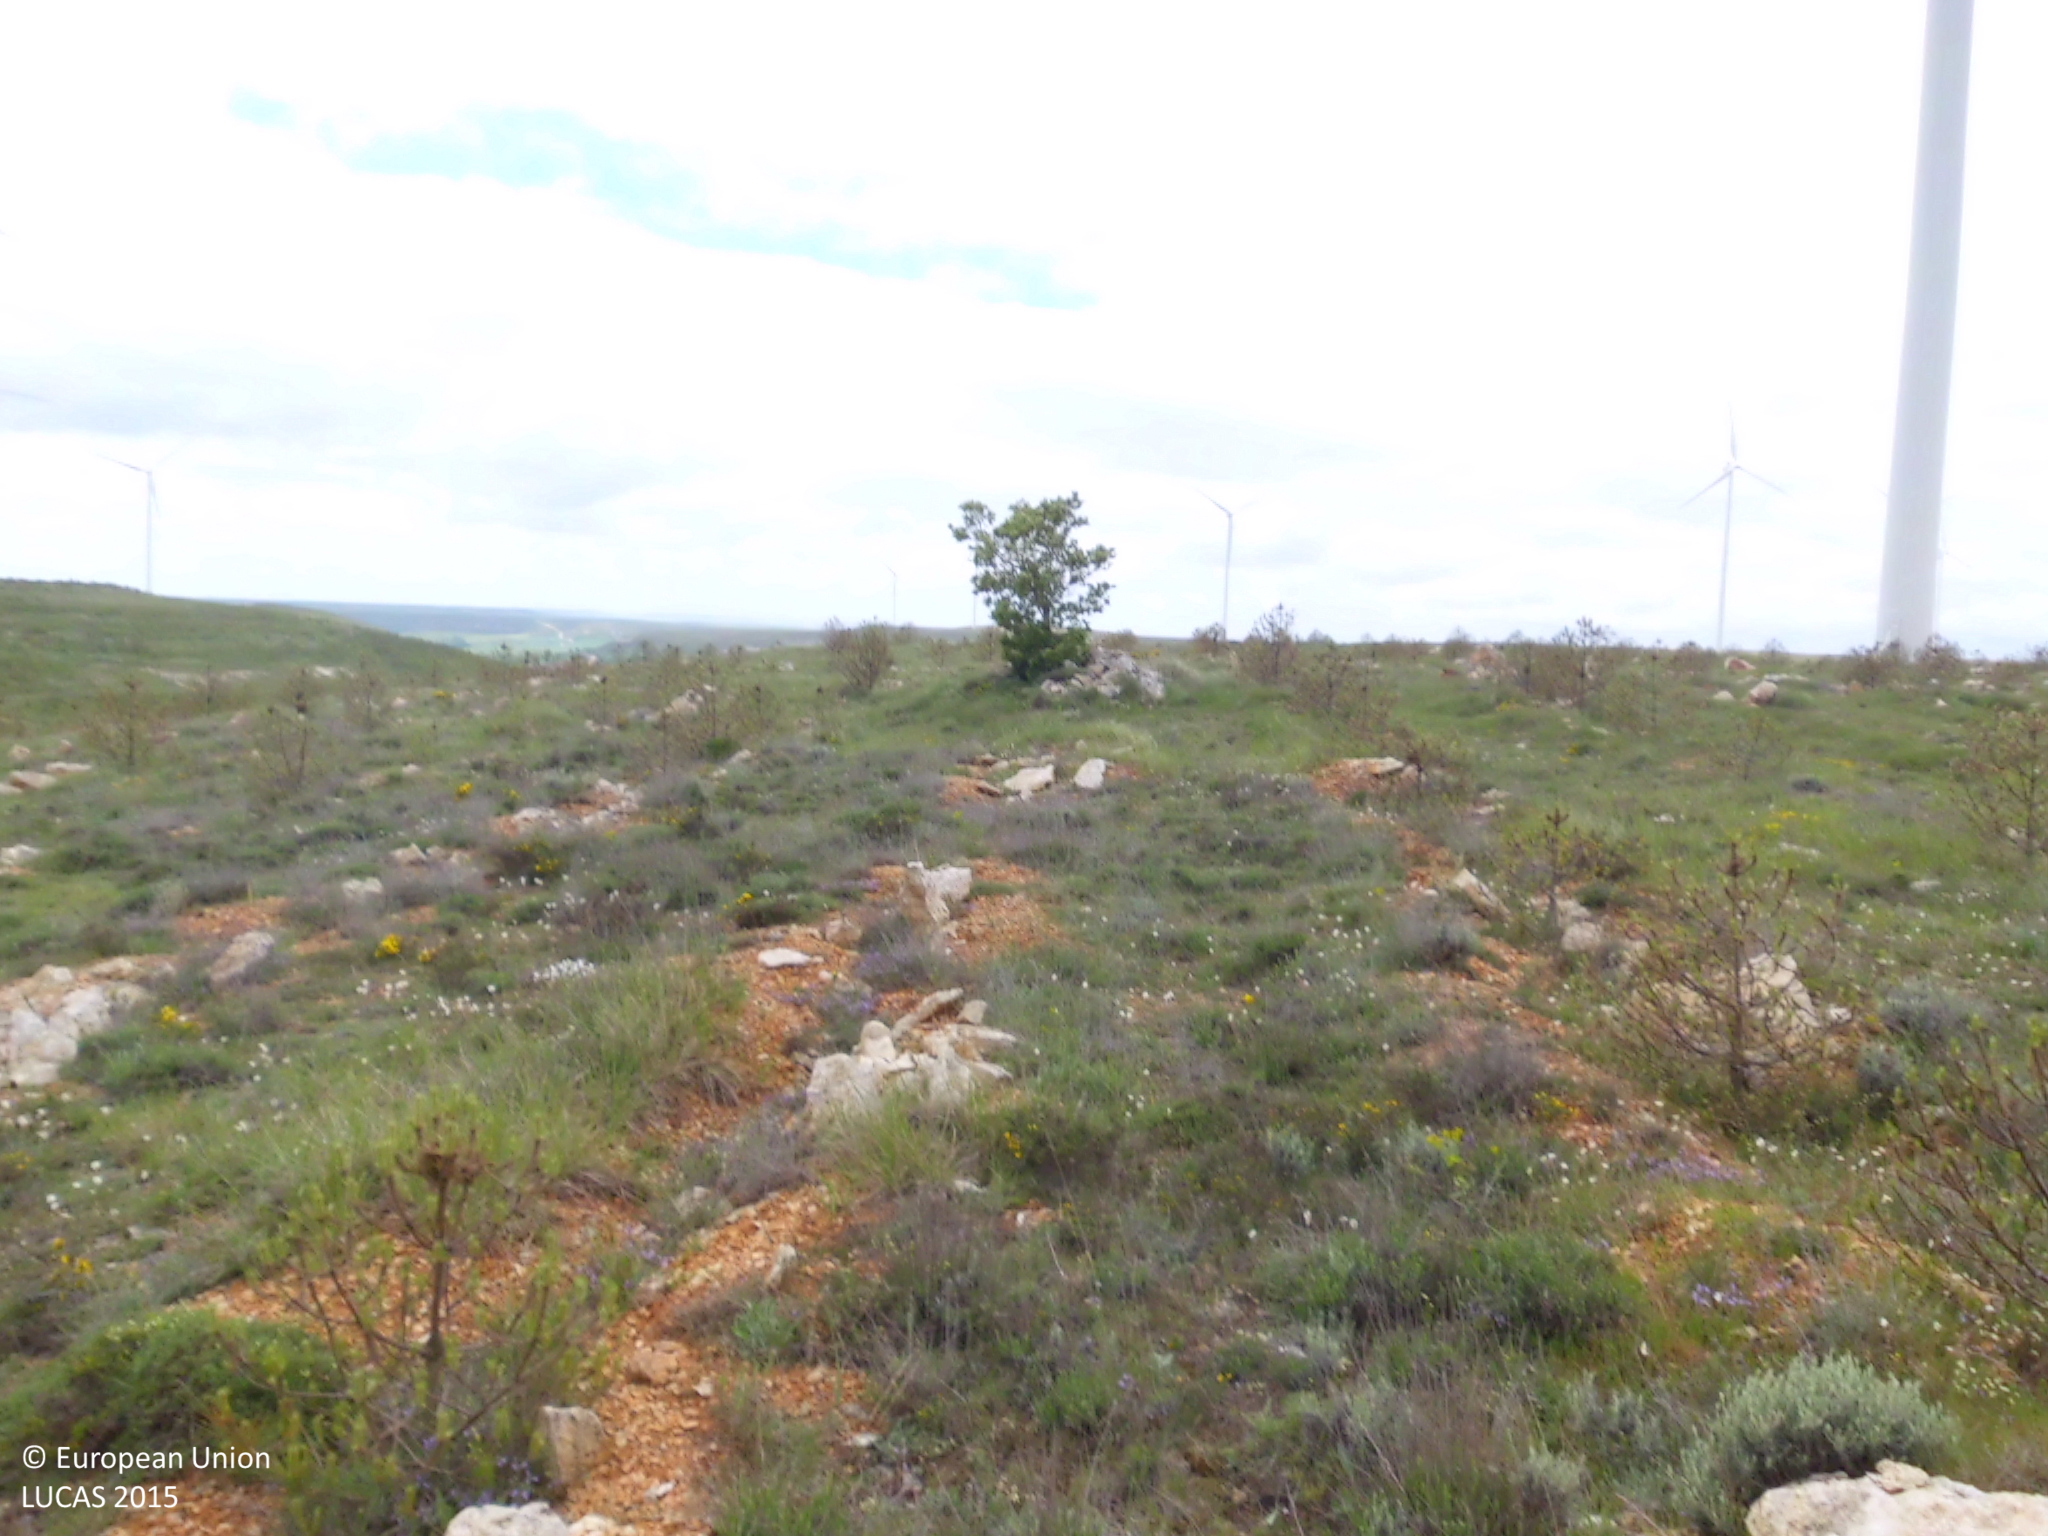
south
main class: Woodland
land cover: Pine dominated coniferous woodland
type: coniferous forest of the mediterranean region
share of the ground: > 75 %
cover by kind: herbaceous plants 60 %, unconsolidated bare surface 20 %, coniferous forest trees 15 %, shrubs 5 %
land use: Forestry
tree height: < 5 m
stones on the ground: 25 - 50 %
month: May
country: ES
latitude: 42.5485
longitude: -3.9124
